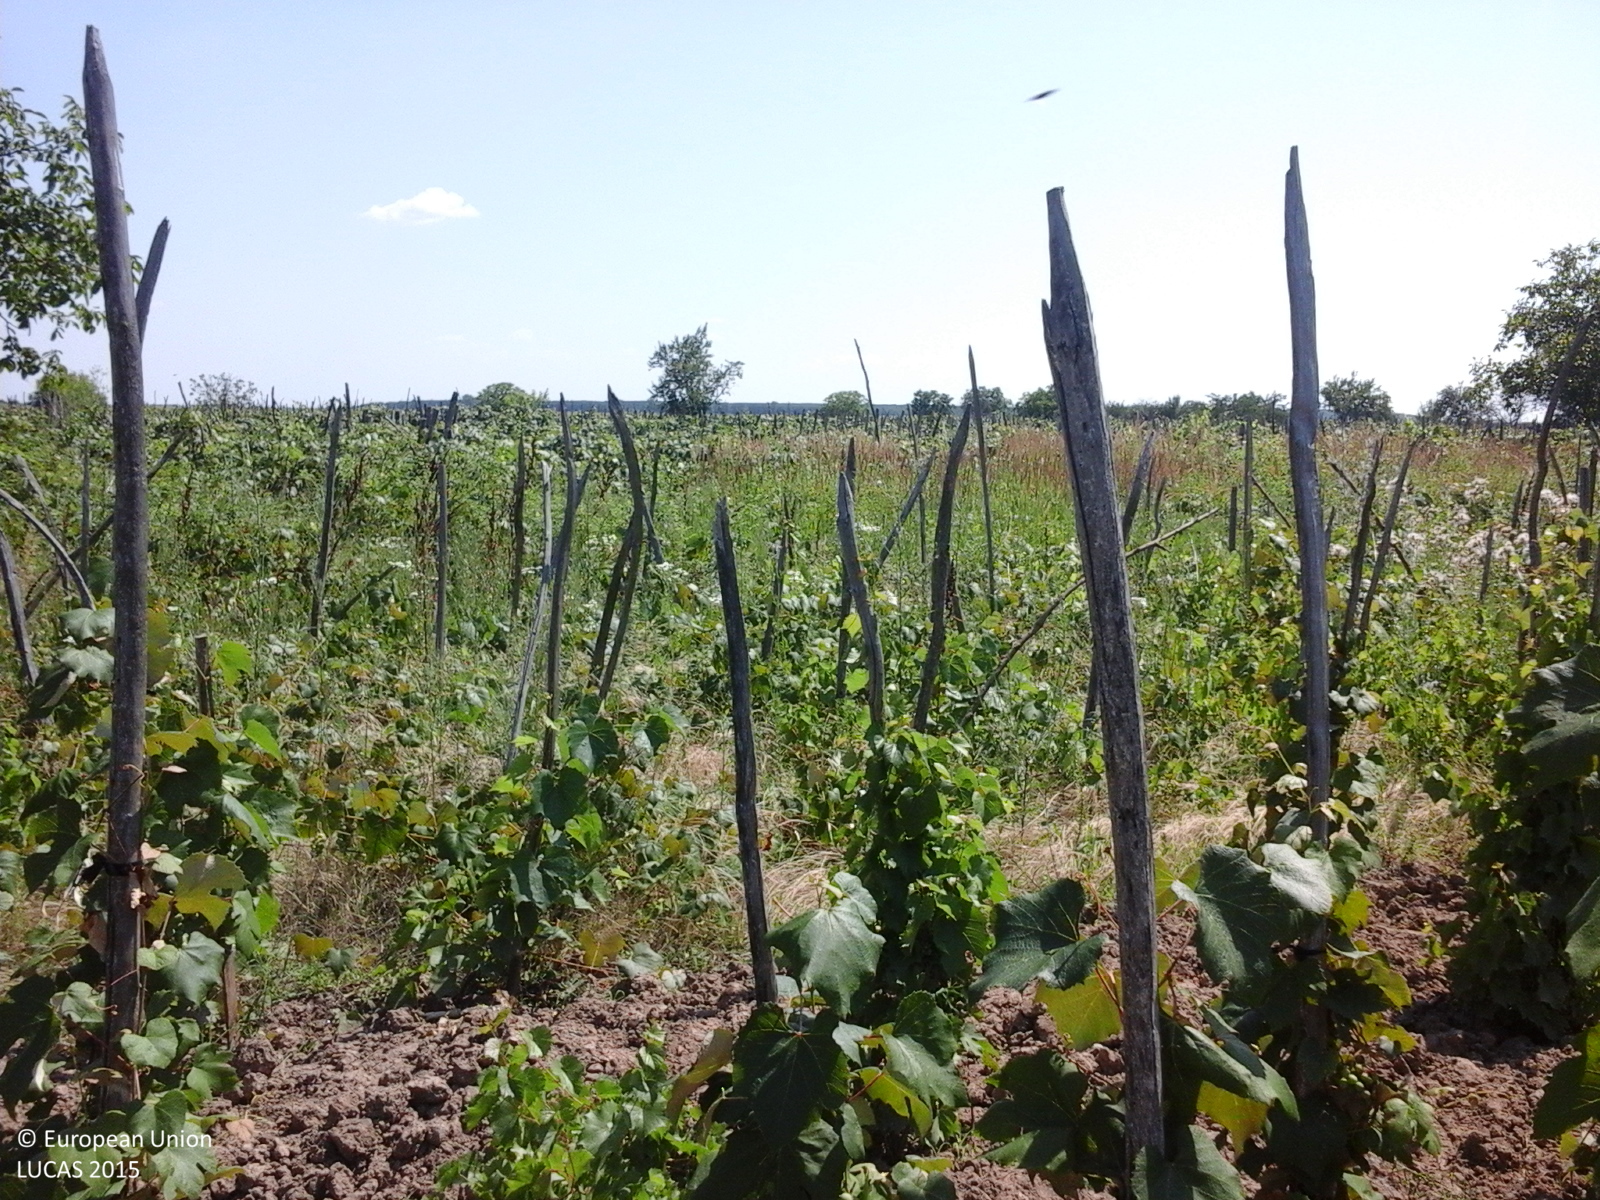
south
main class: Cropland
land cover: Vineyards
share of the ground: 50 - 75 %
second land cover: Other bare soil
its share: > 75 %
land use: Agriculture (excluding fallow land and kitchen gardens)
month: July
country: RO
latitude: 44.4446
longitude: 24.4824
